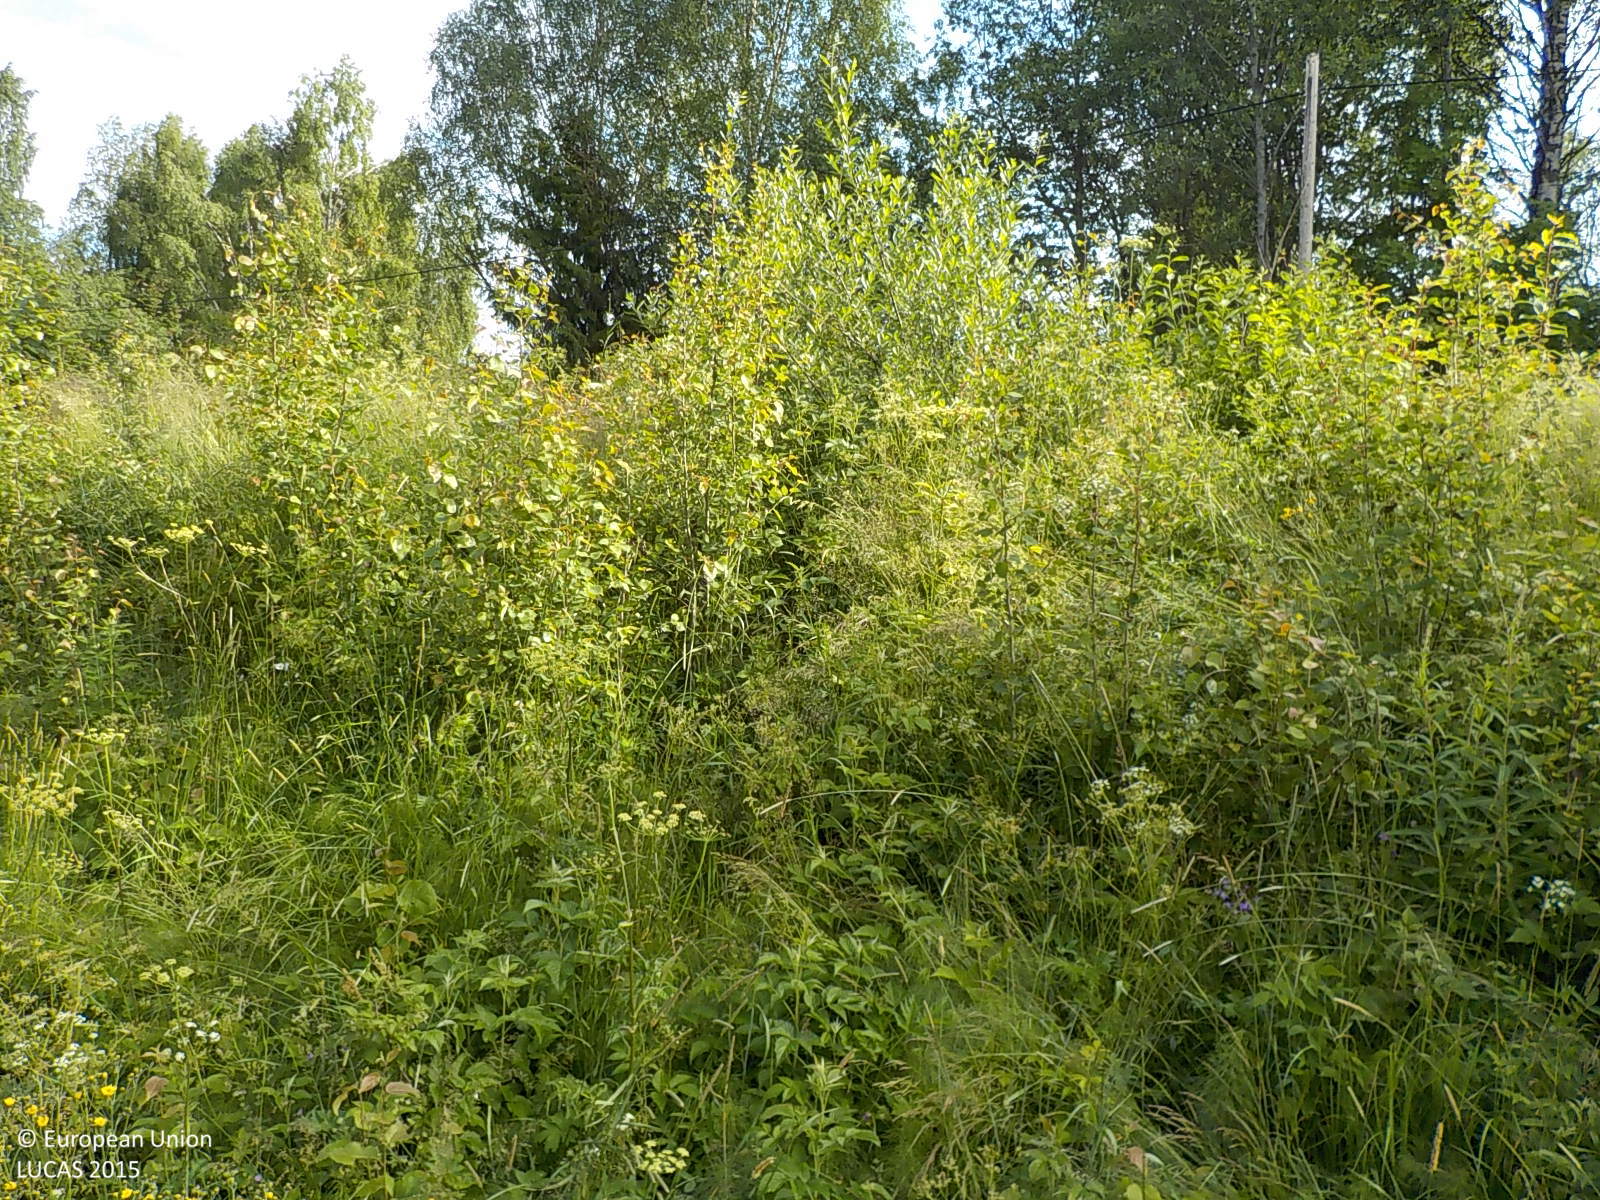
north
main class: Woodland
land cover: Broadleaved woodland
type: boreal forest
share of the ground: 50 - 75 %
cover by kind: broadleaved forest trees 50 %, herbaceous plants 50 %
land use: Forestry
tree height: < 5 m
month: July
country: SE
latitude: 63.1817
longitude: 17.2272
